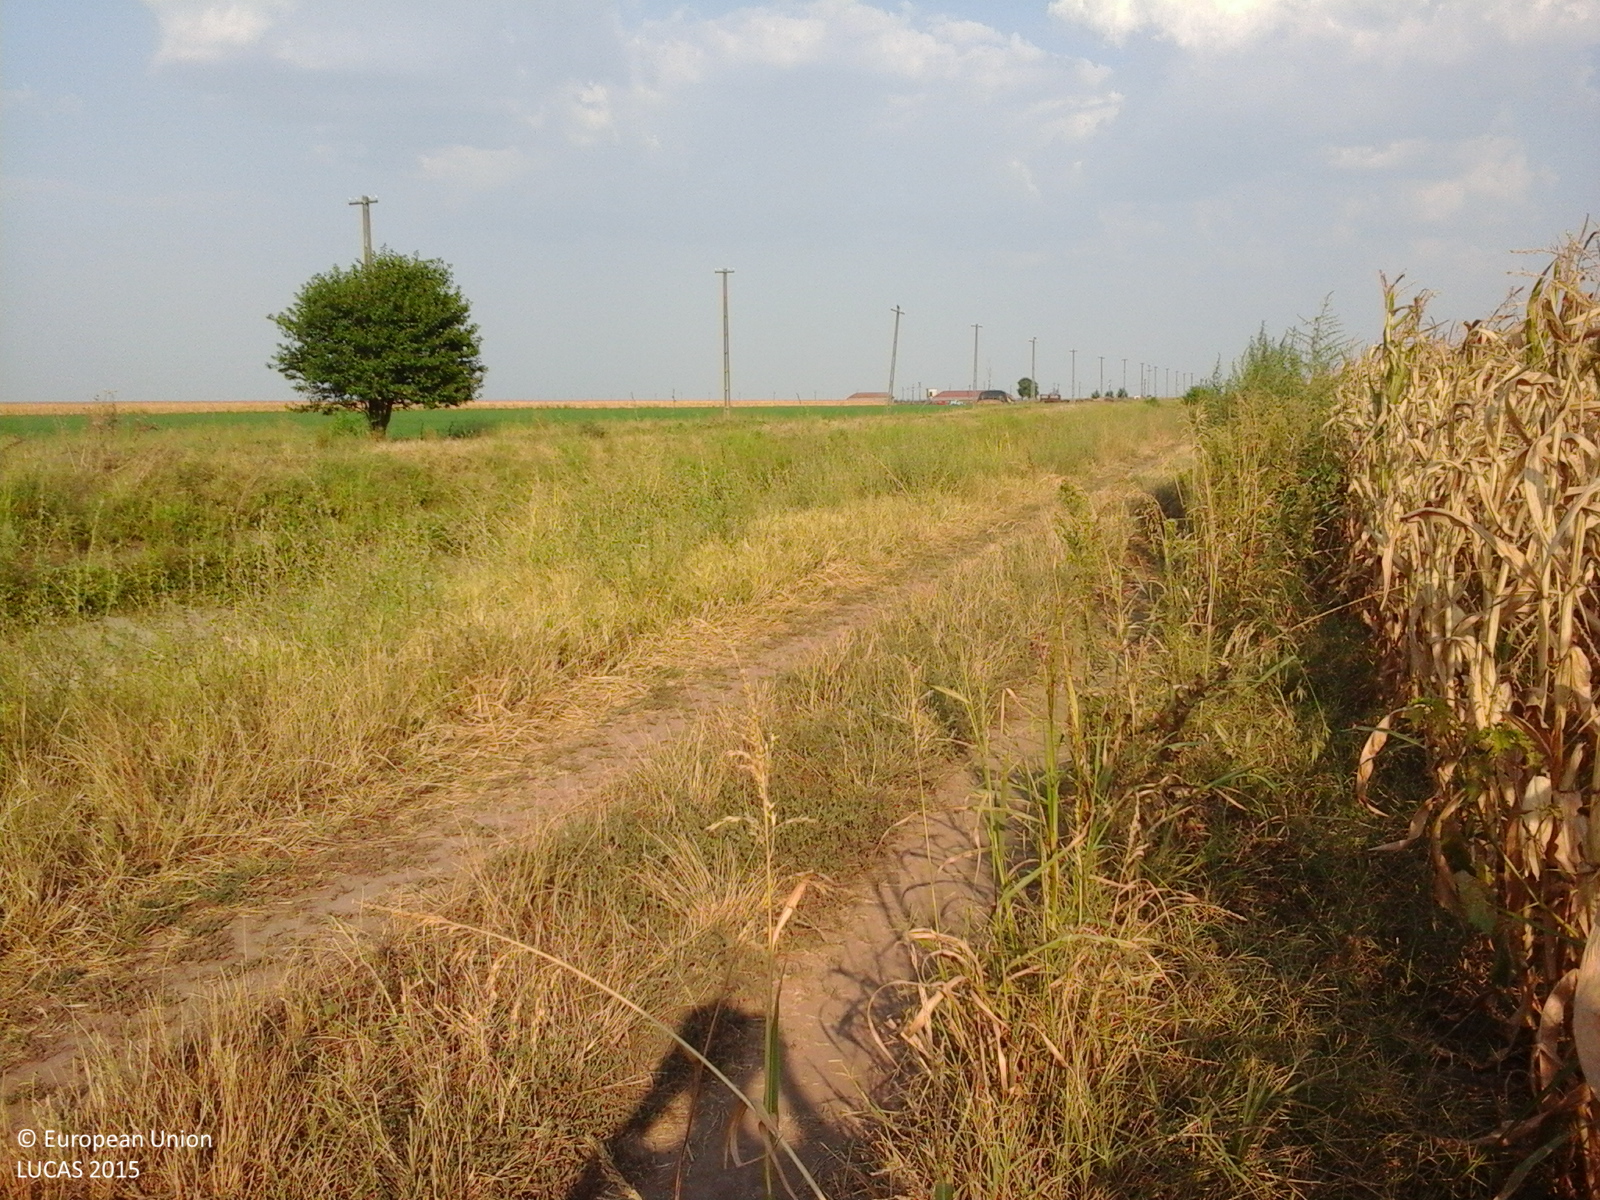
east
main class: Cropland
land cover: Maize
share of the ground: > 75 %
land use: Agriculture (excluding fallow land and kitchen gardens)
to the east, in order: Maize
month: August
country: RO
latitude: 43.9992
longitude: 23.1757
